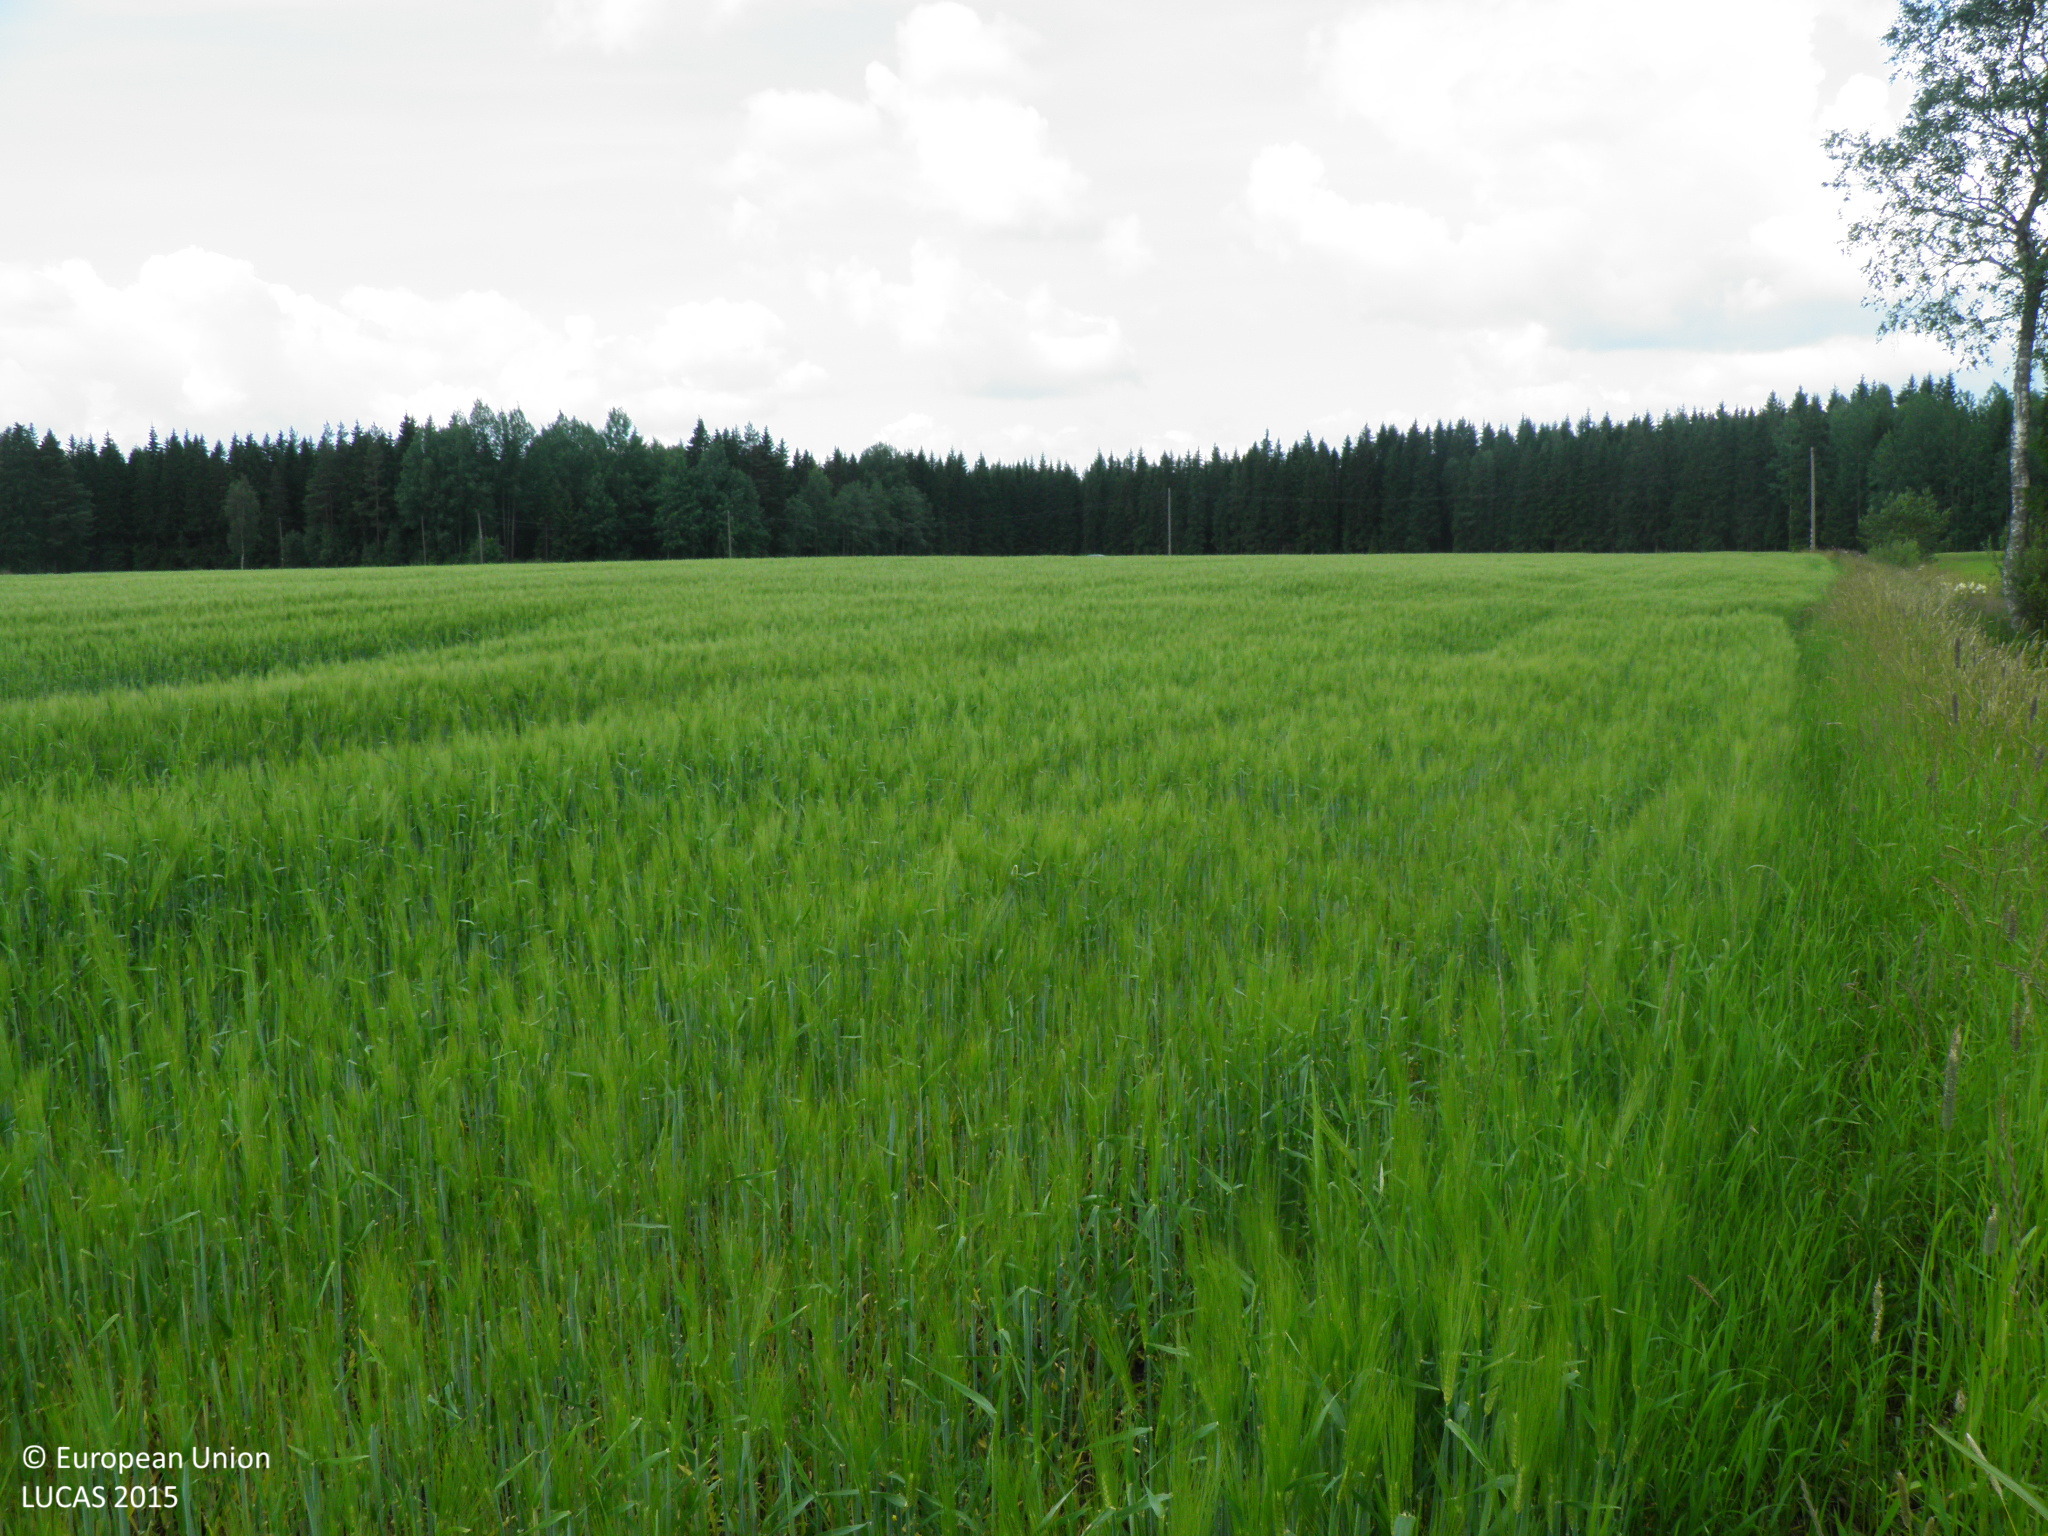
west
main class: Cropland
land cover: Barley
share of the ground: > 75 %
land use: Agriculture (excluding fallow land and kitchen gardens)
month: July
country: FI
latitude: 60.6553
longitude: 22.3787
